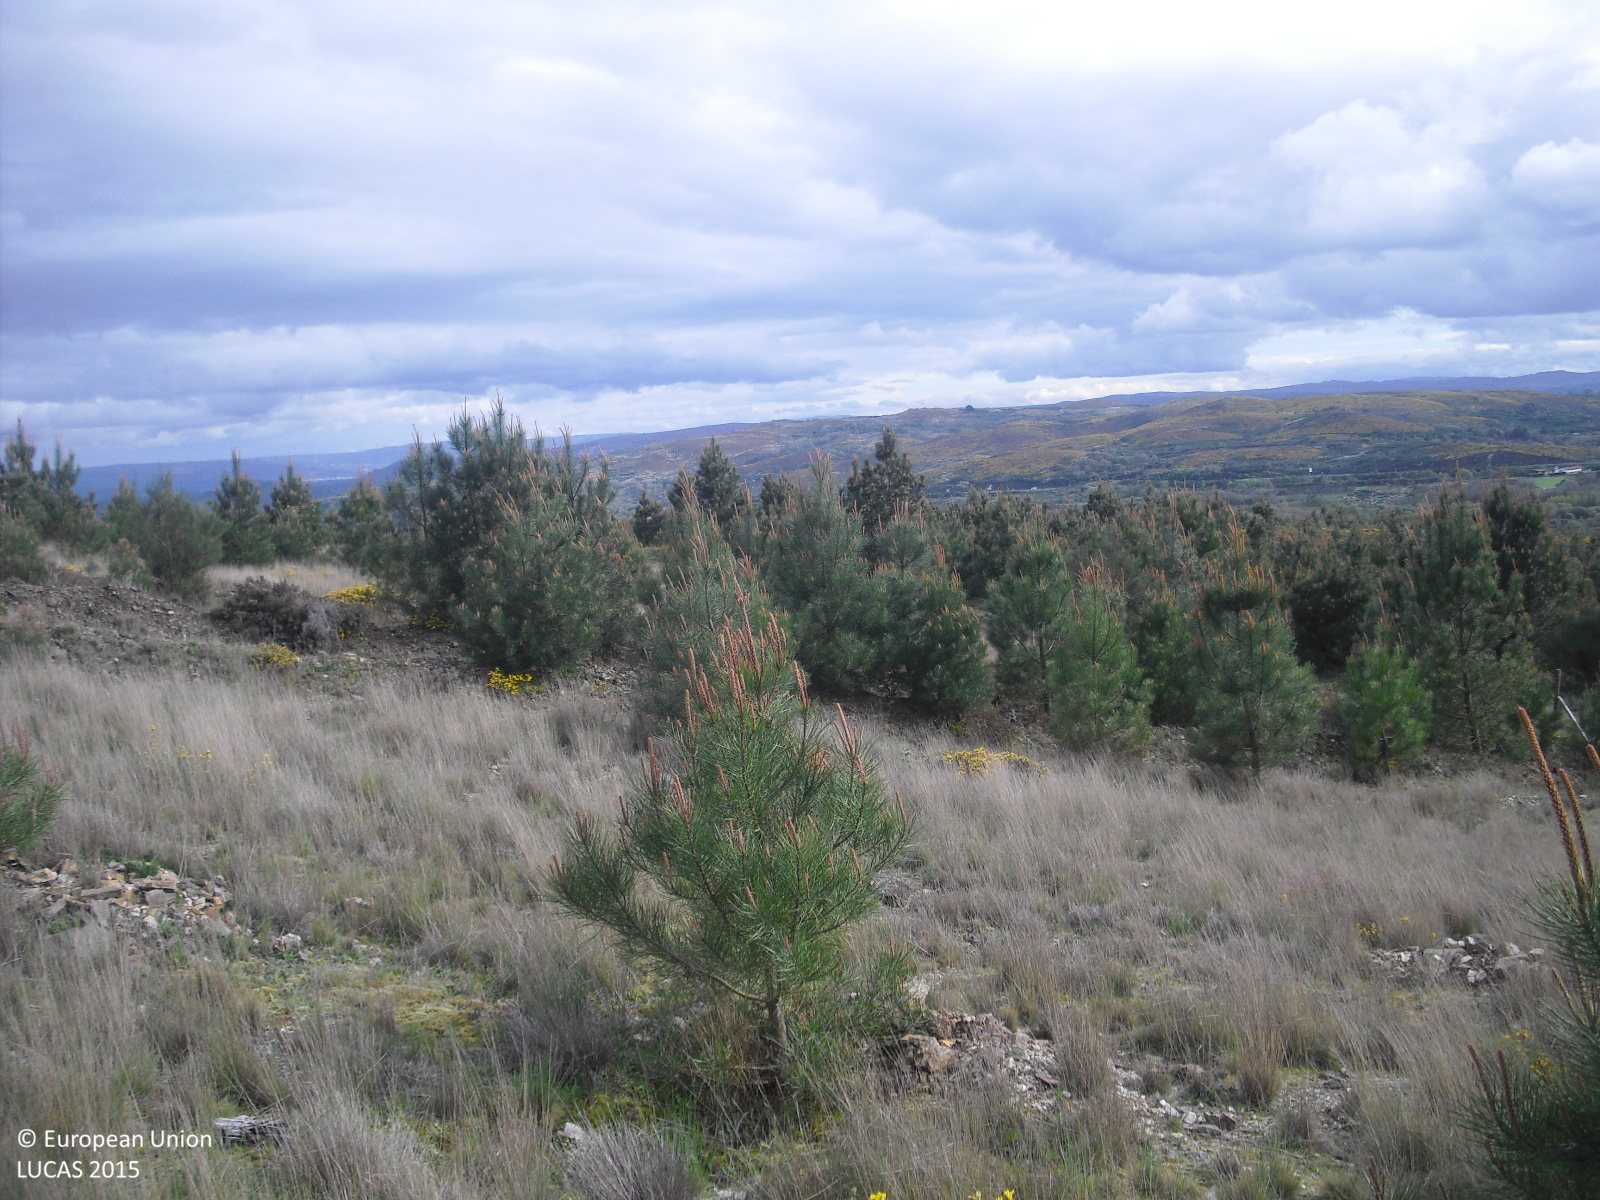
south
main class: Woodland
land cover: Pine dominated coniferous woodland
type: exotic forest
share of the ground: 10 - 25 %
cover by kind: shrubs 30 %, herbaceous plants 30 %, unconsolidated bare surface 30 %, coniferous forest trees 10 %
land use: Forestry
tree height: < 5 m
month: April
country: ES
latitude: 41.9958
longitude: -7.5314
